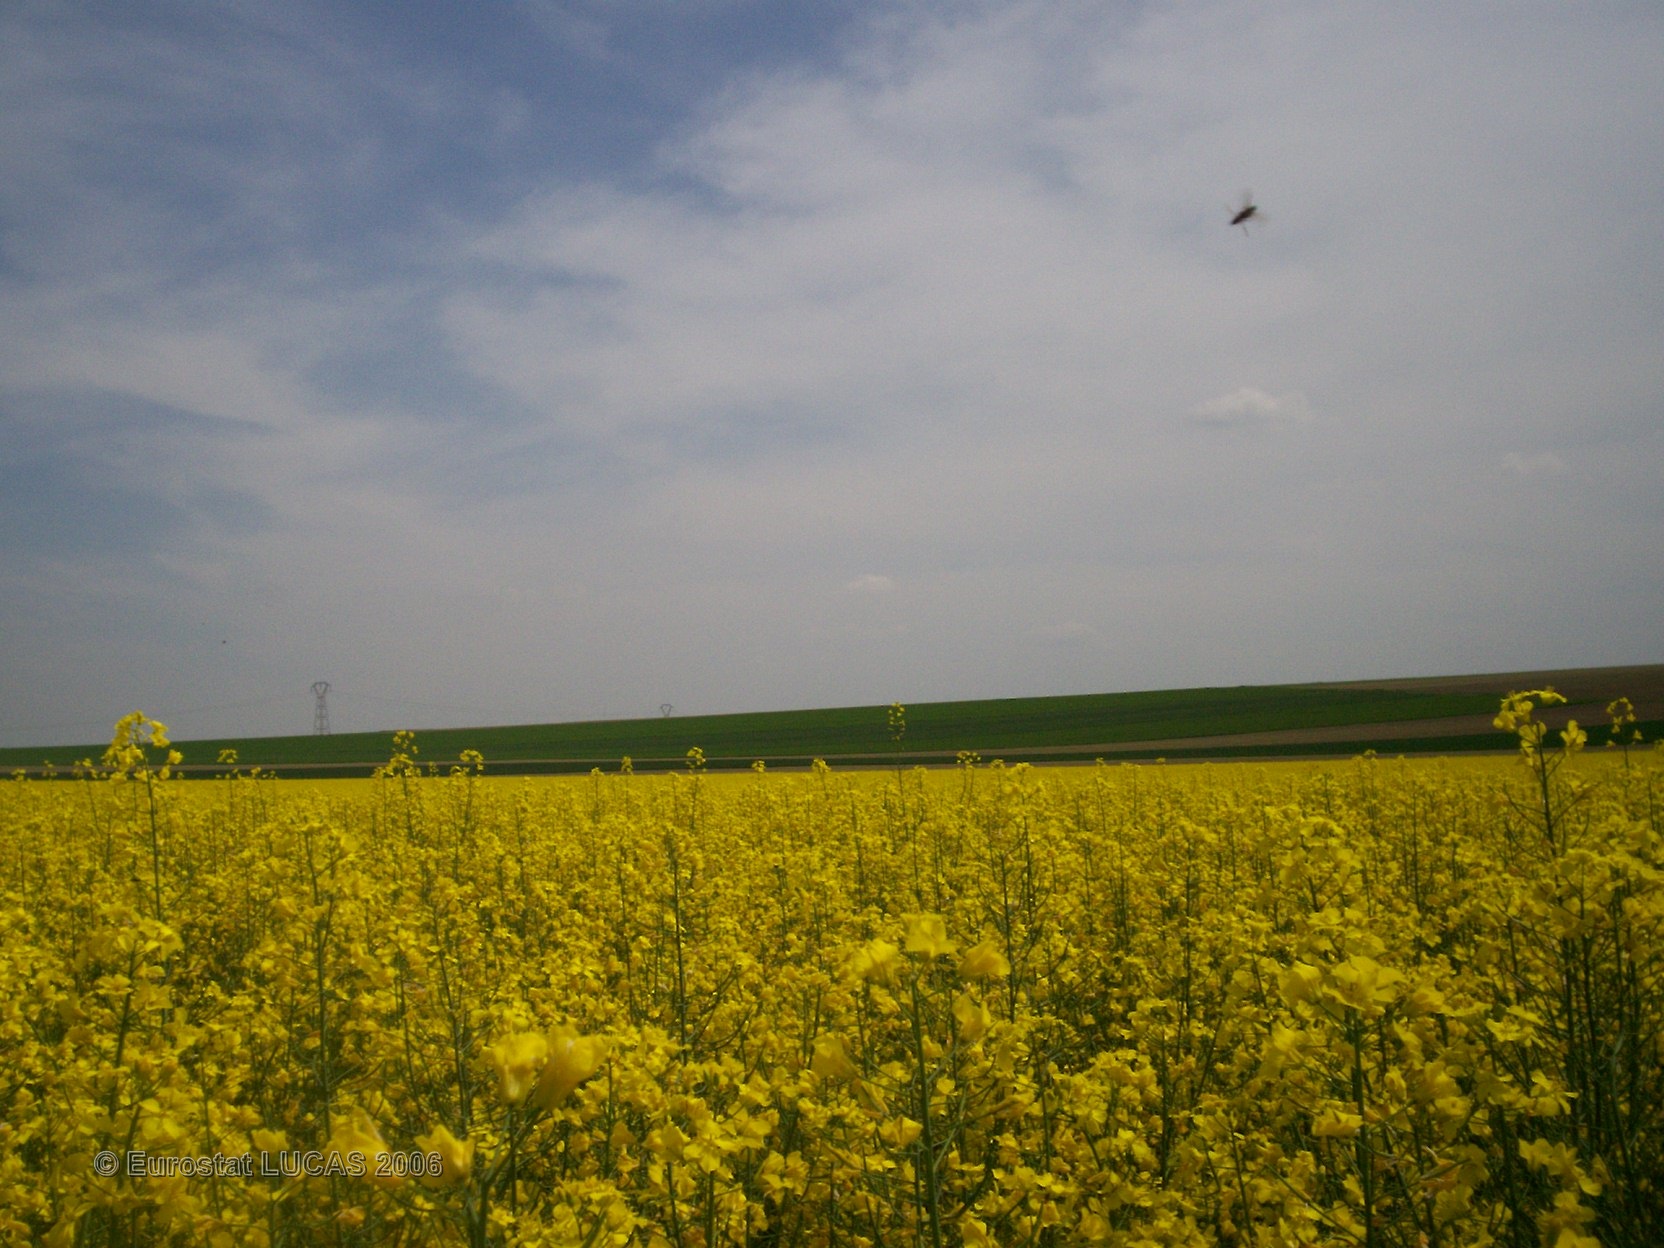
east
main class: Cropland
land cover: Rape and turnip rape
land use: Agriculture (excluding fallow land and kitchen gardens)
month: May
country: FR
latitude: 48.9309
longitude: 4.4410
